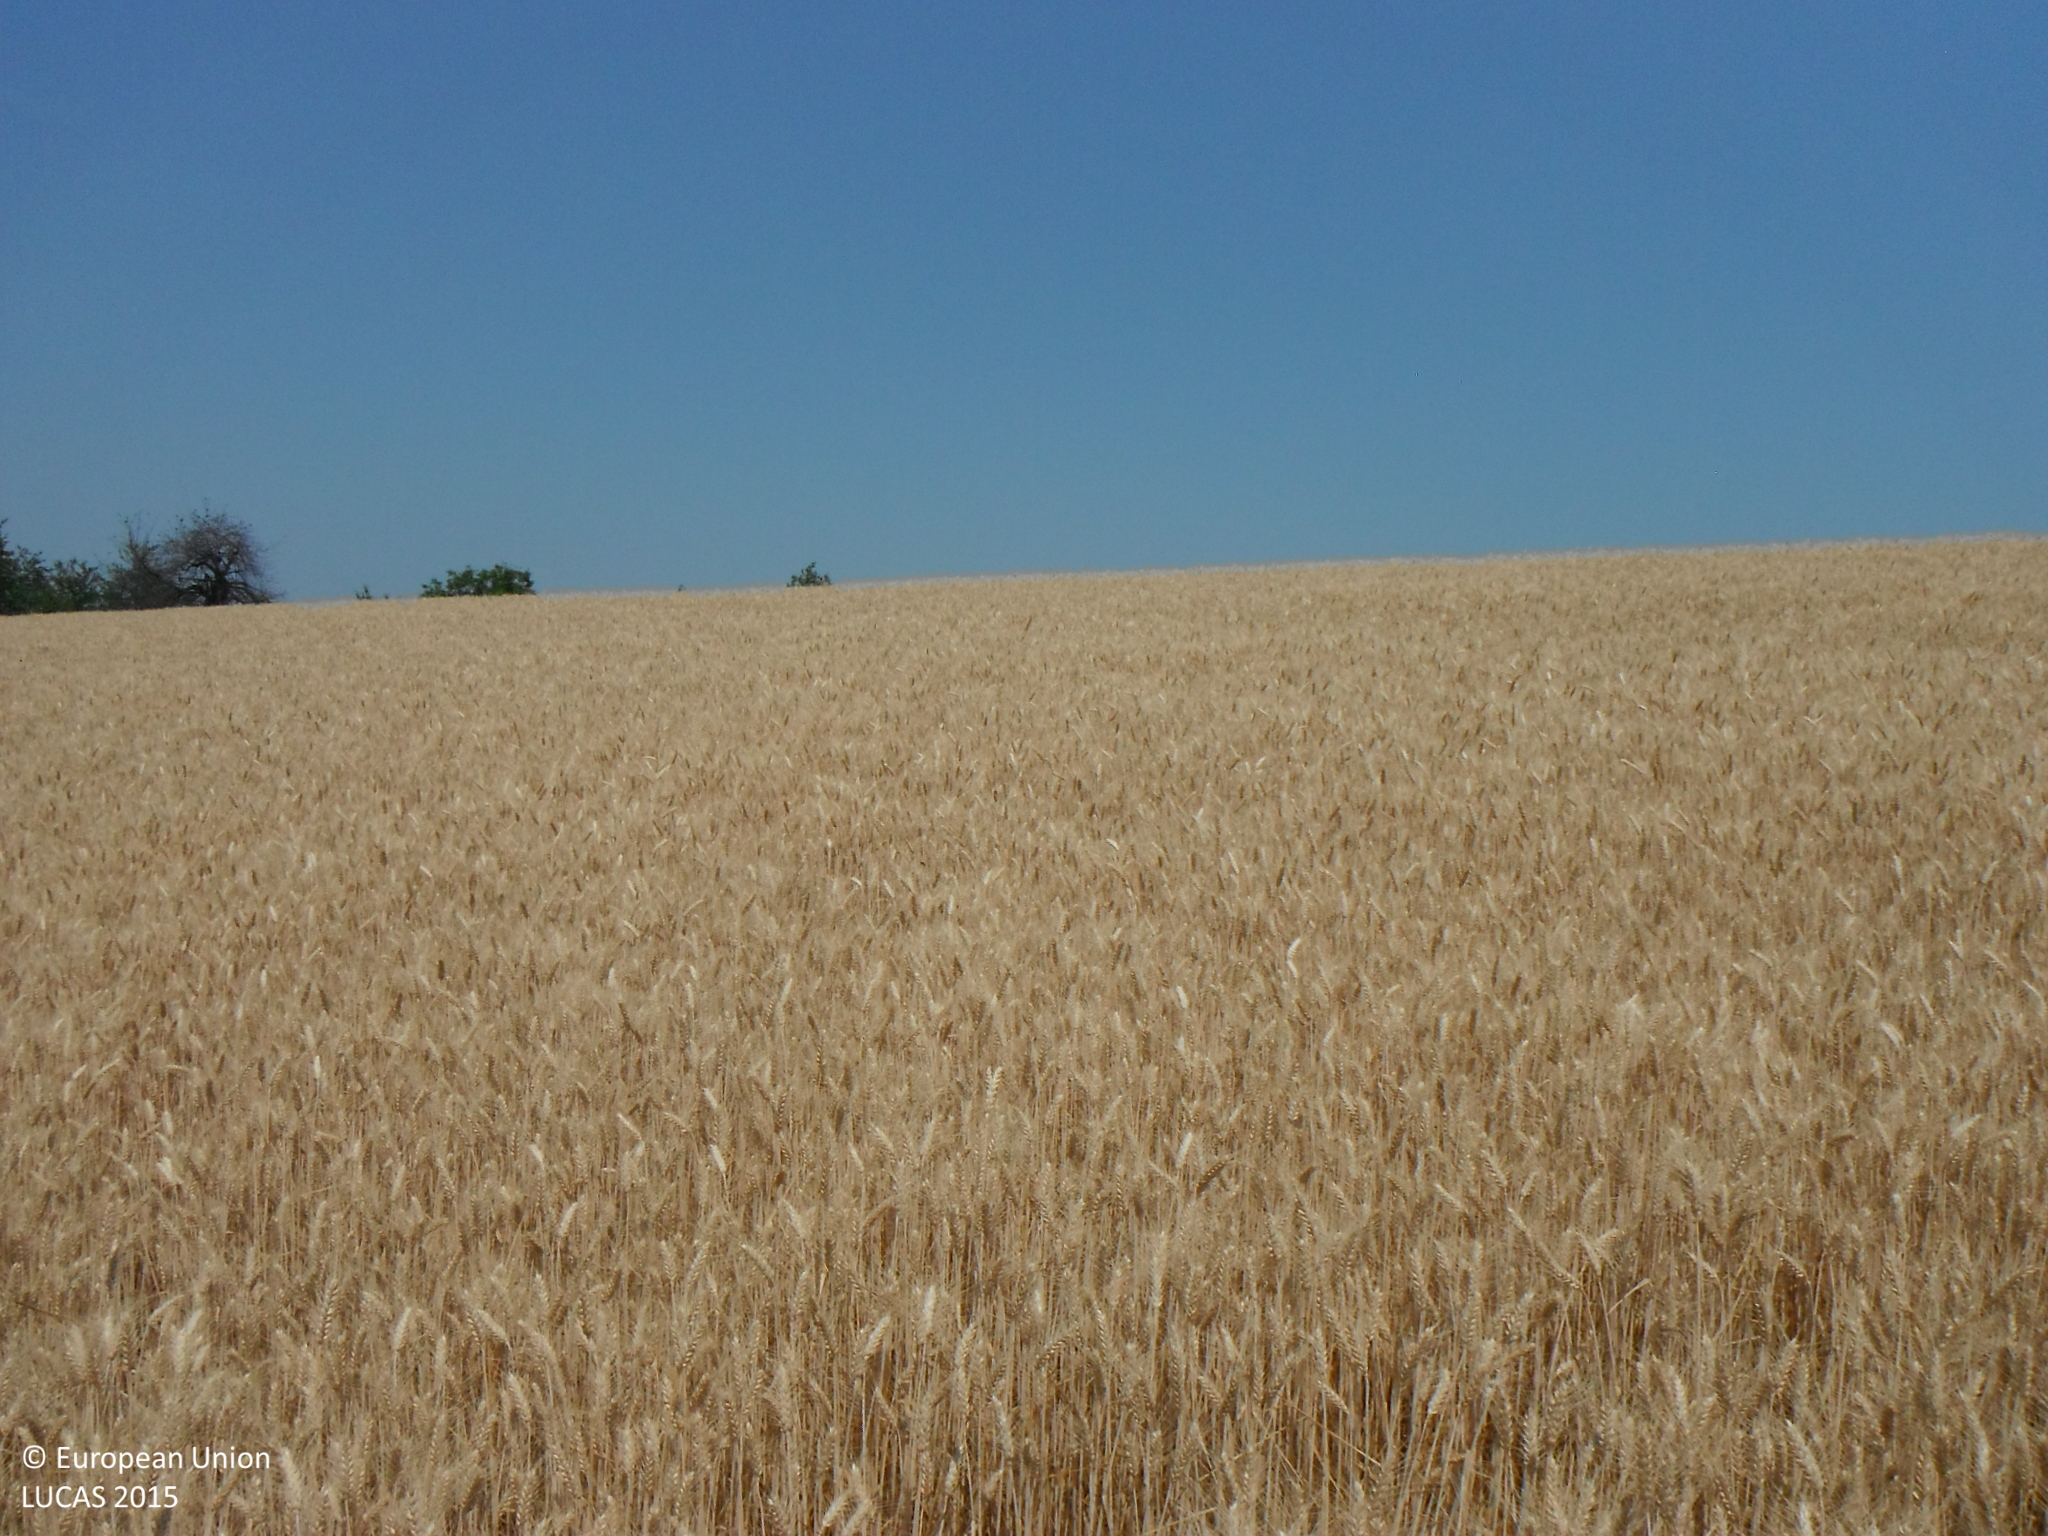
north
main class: Cropland
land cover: Common wheat
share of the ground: > 75 %
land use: Agriculture (excluding fallow land and kitchen gardens)
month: July
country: SK
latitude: 48.2061
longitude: 19.1307
